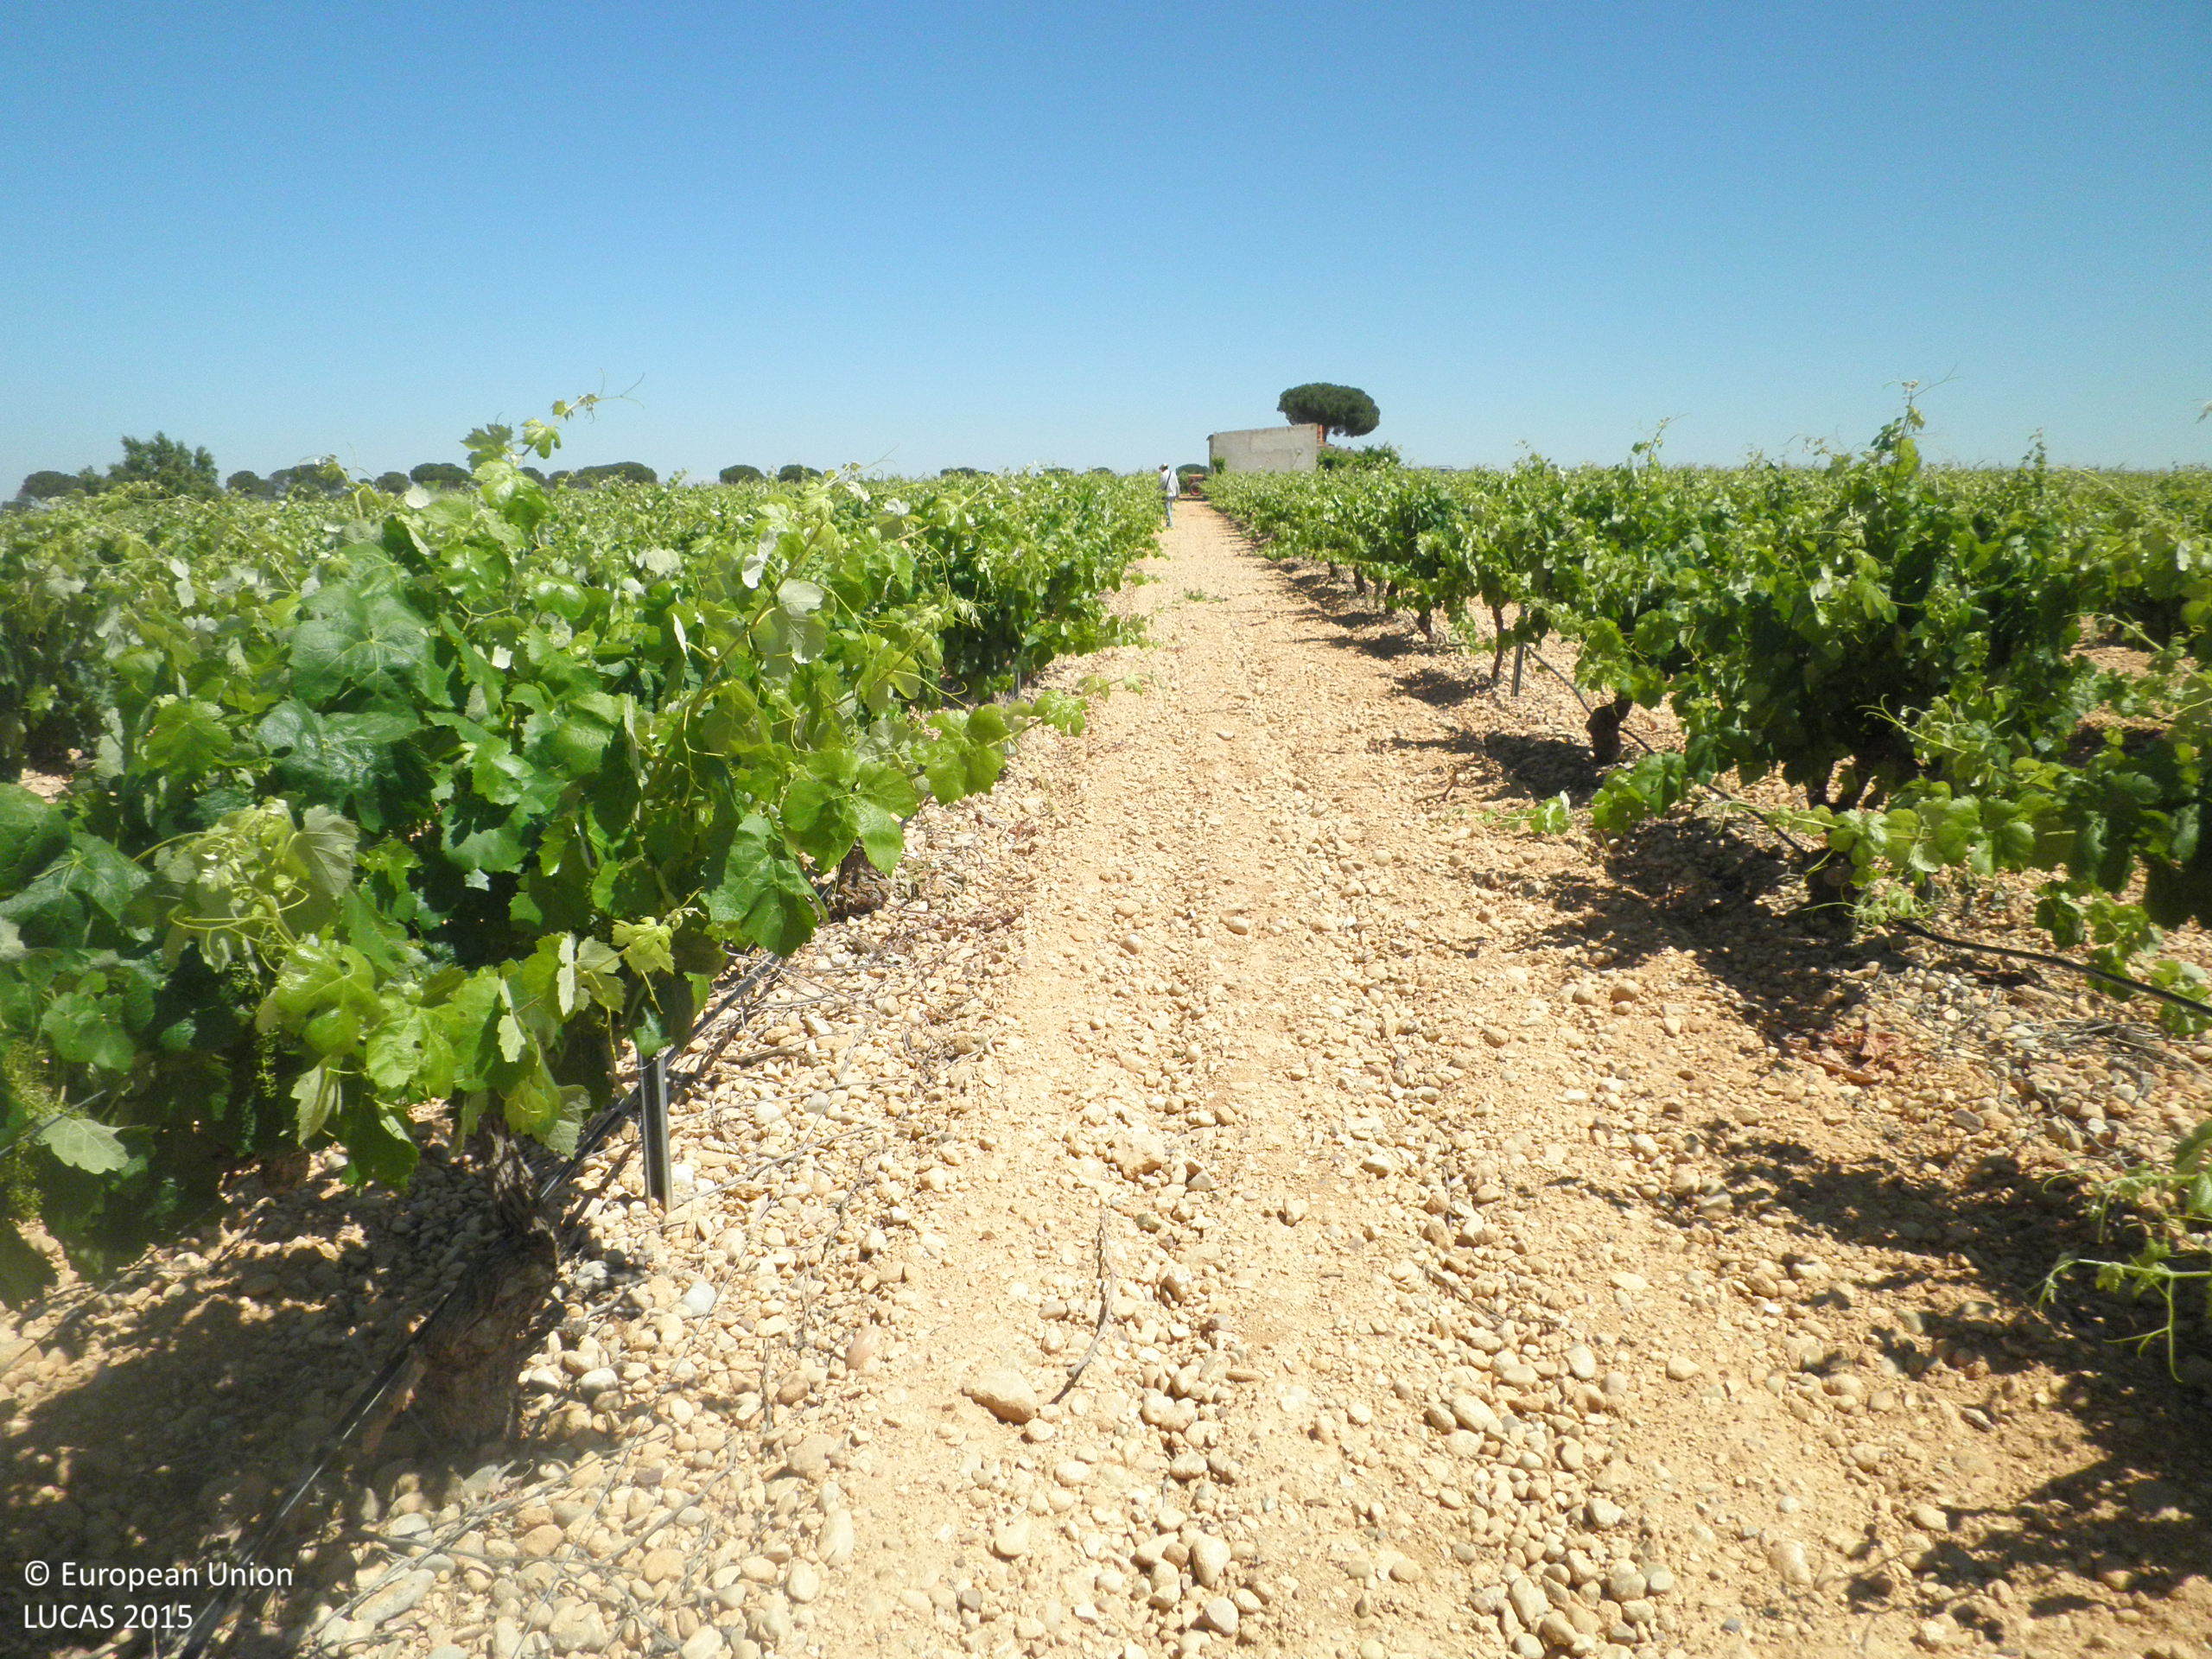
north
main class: Cropland
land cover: Vineyards
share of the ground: 10 - 25 %
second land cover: Other bare soil
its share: > 75 %
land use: Agriculture (excluding fallow land and kitchen gardens)
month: June
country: ES
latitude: 39.3497
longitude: -1.6654
